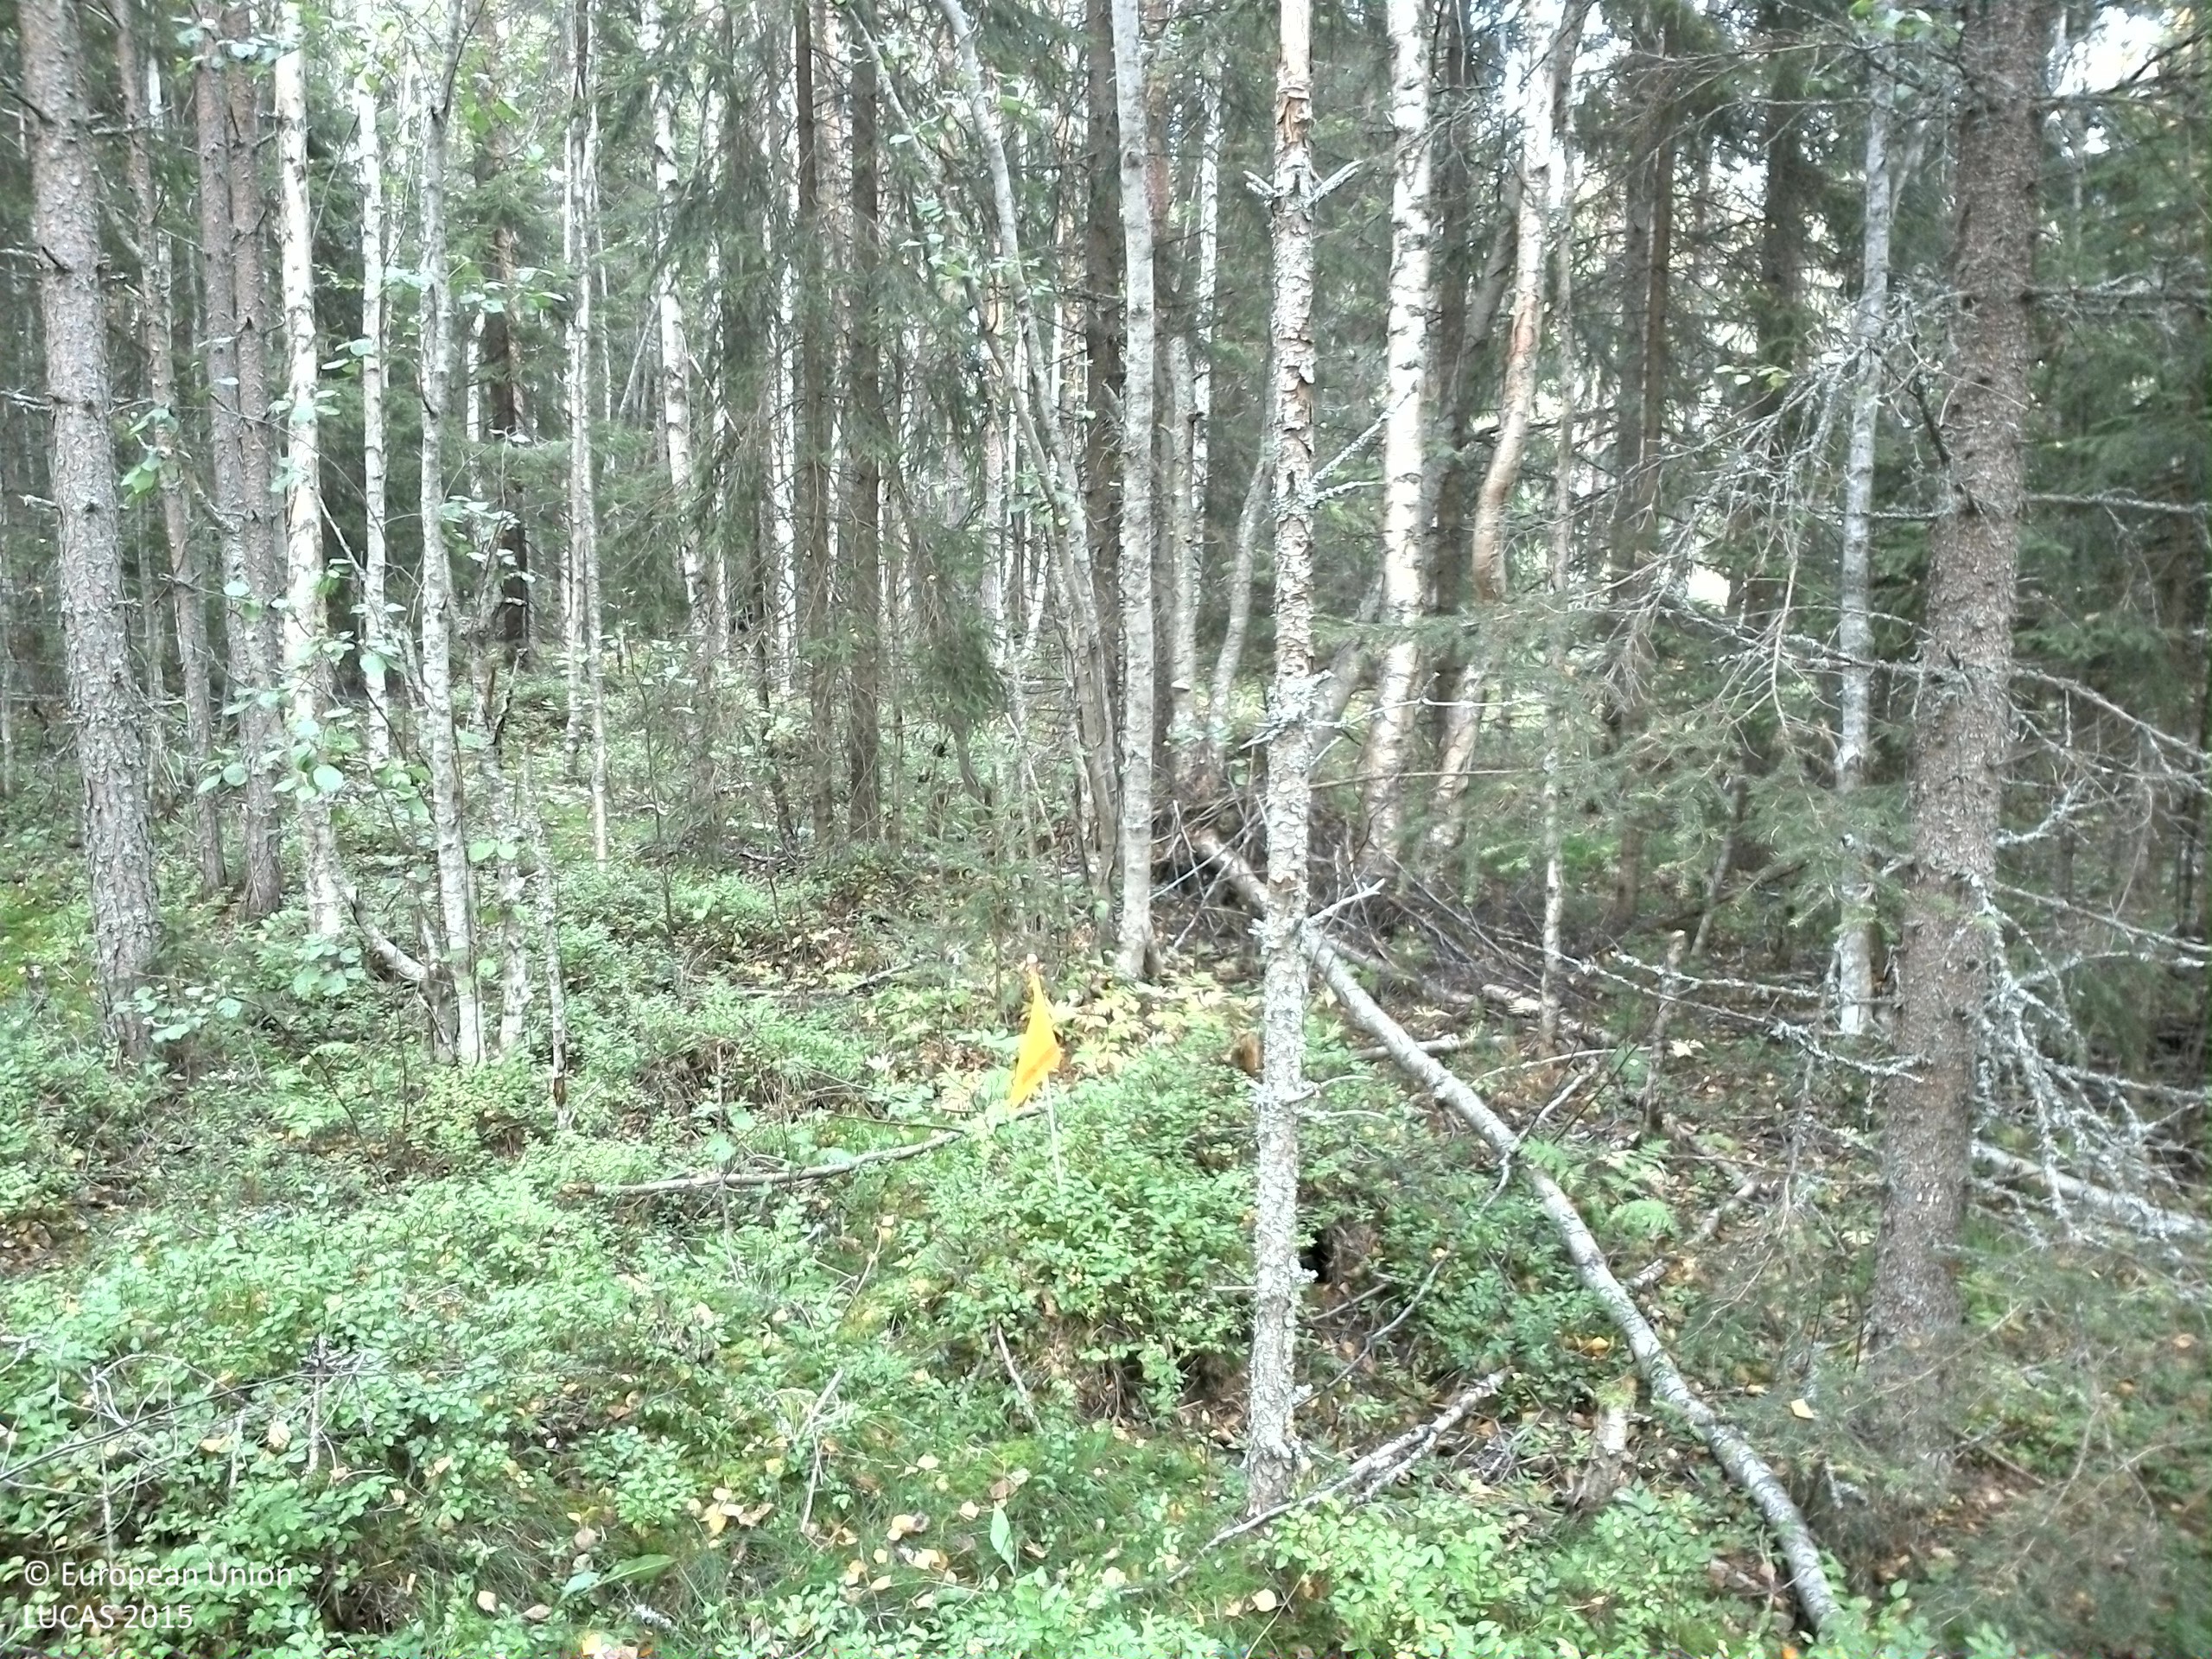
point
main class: Woodland
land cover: Spruce dominated mixed woodland
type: boreal forest
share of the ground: > 75 %
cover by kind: coniferous forest trees 50 %, broadleaved forest trees 25 %, shrubs 20 %, lichens and mosses 5 %
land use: Forestry
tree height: > 5 m
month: September
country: SE
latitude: 61.2684
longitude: 15.4116
